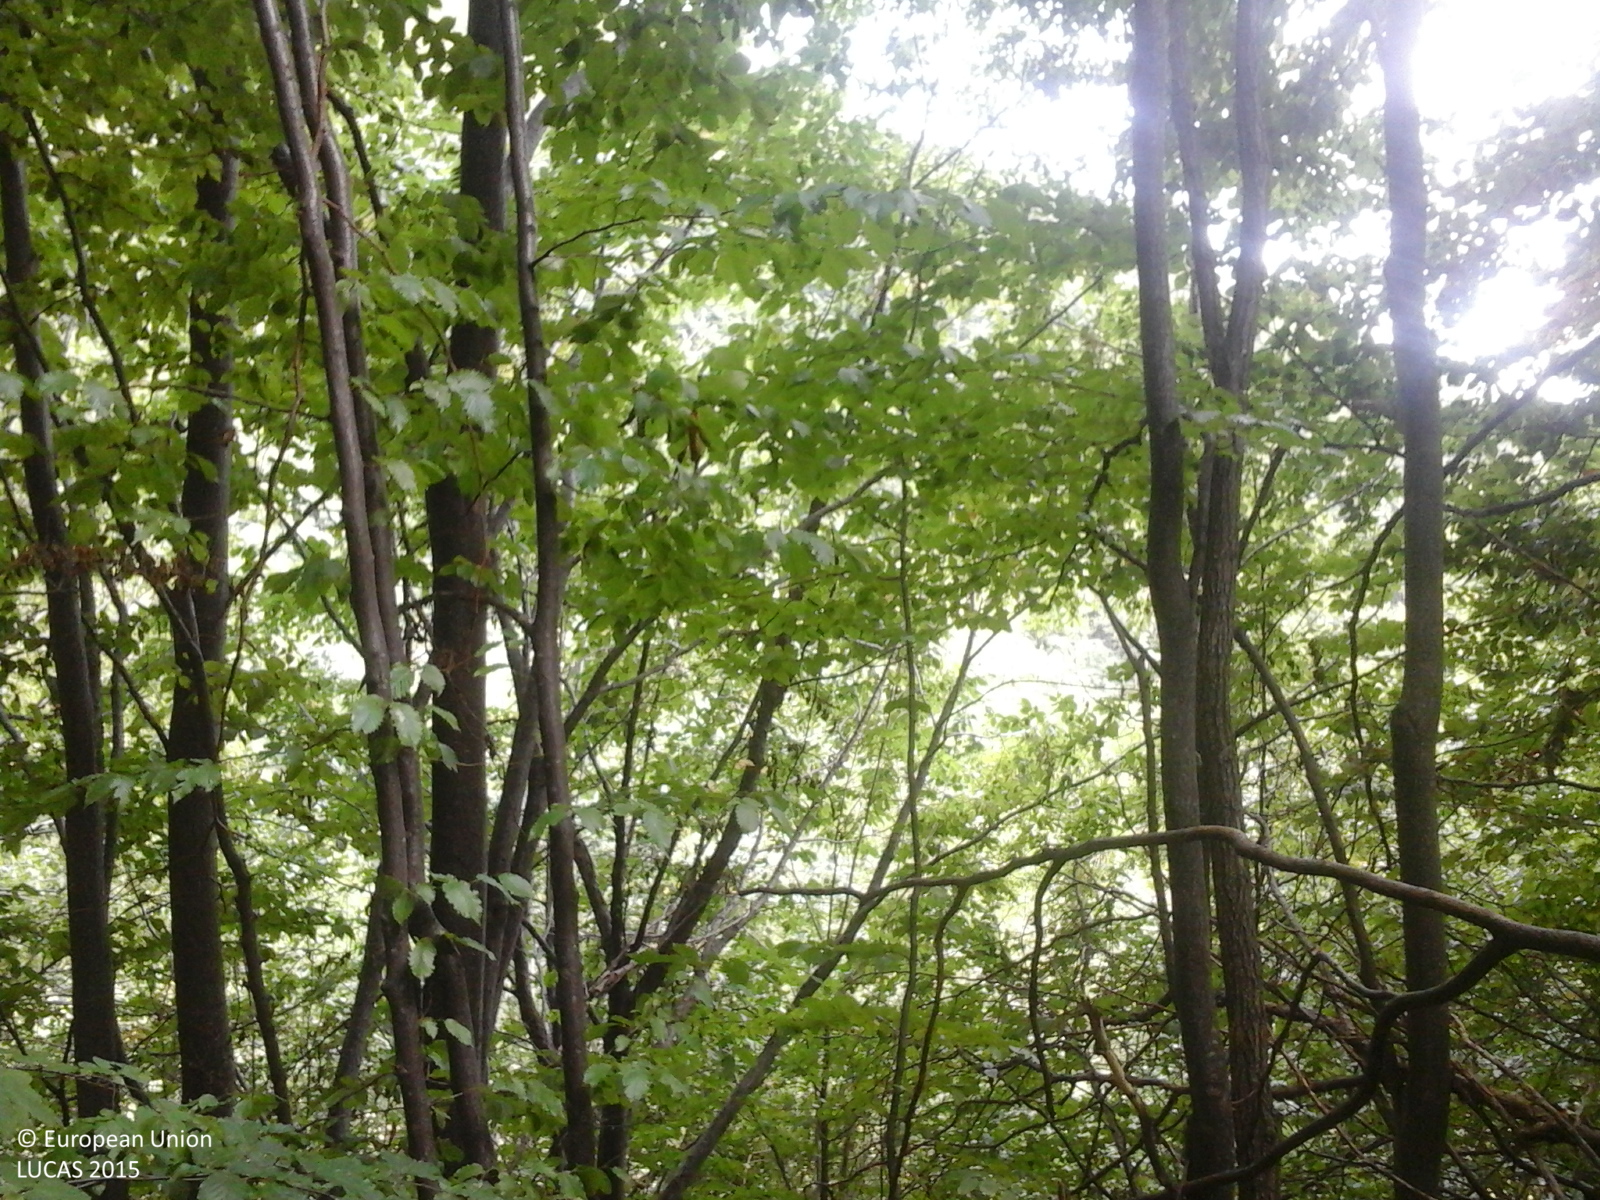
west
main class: Woodland
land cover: Broadleaved woodland
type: beech forest
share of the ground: > 75 %
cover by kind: broadleaved forest trees 100 %
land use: Forestry
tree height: > 5 m
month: September
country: RO
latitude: 45.0145
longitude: 22.4899
